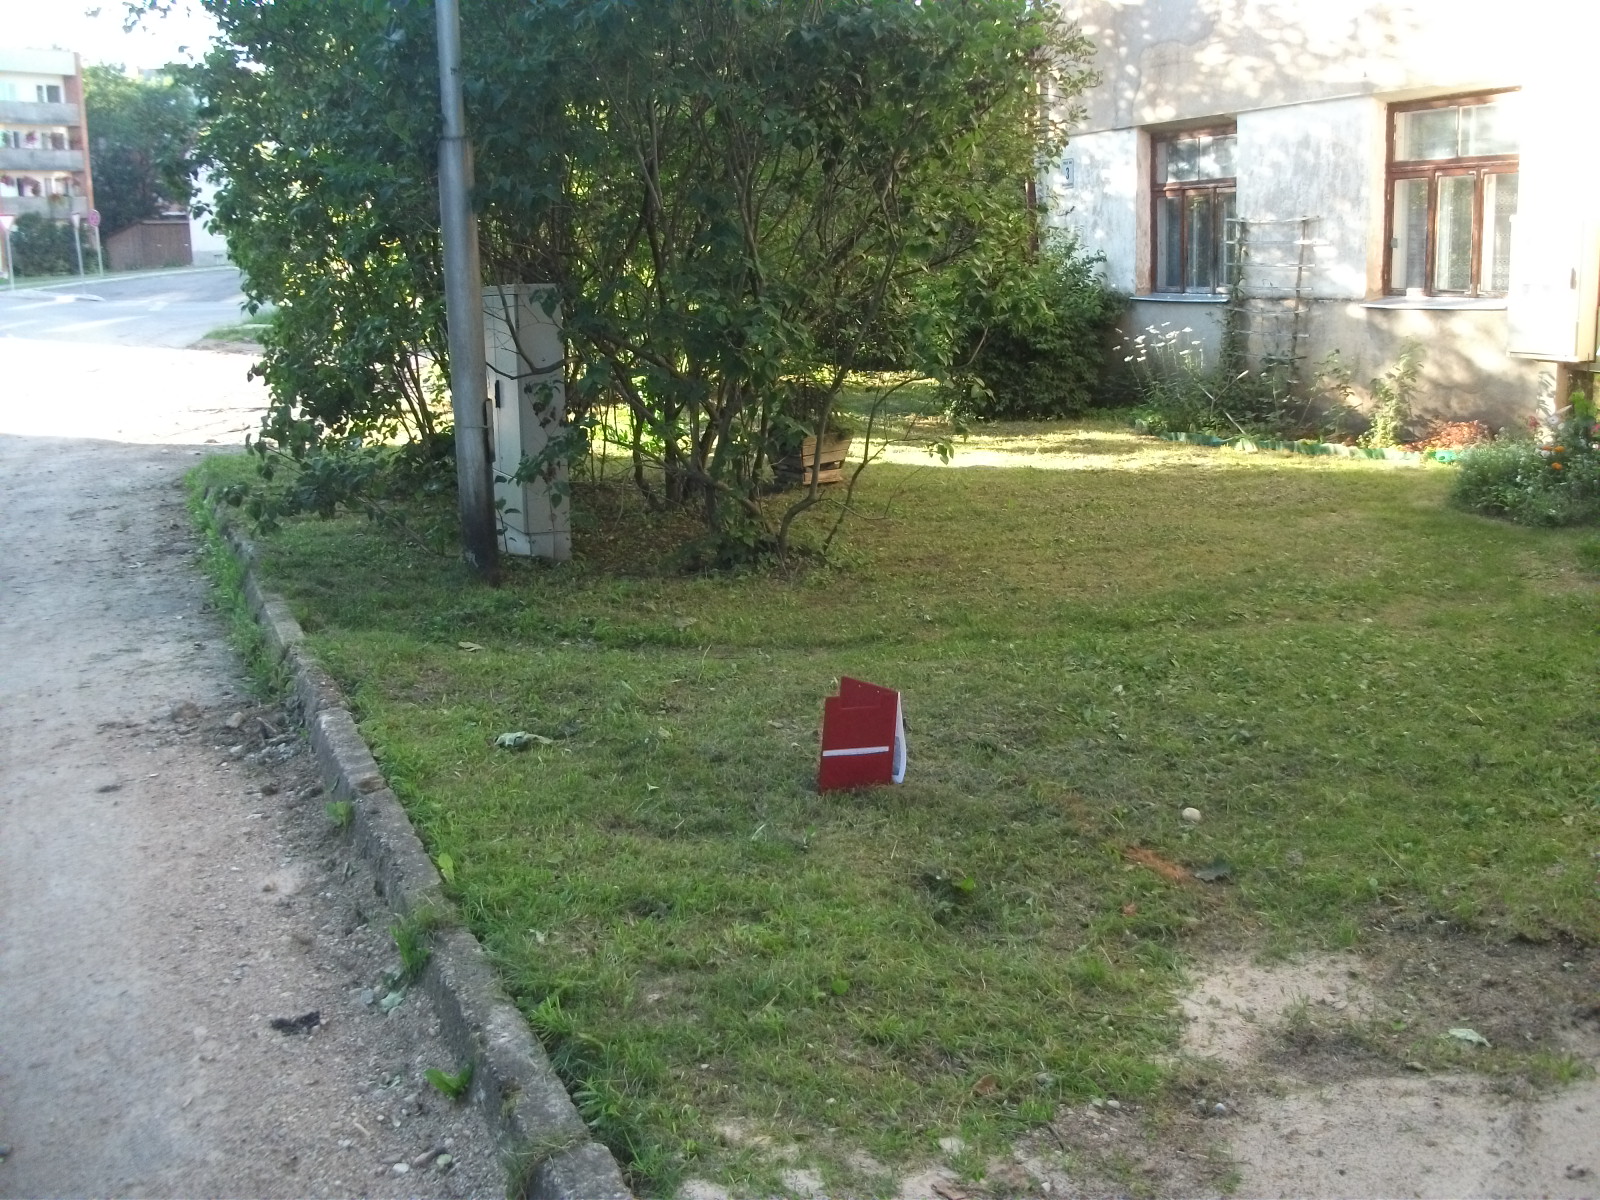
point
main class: Grassland
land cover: Grassland without tree/shrub cover
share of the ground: > 75 %
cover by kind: herbaceous plants 90 %, unconsolidated bare surface 10 %
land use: Residential
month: August
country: LV
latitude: 56.8551
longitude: 26.2256
